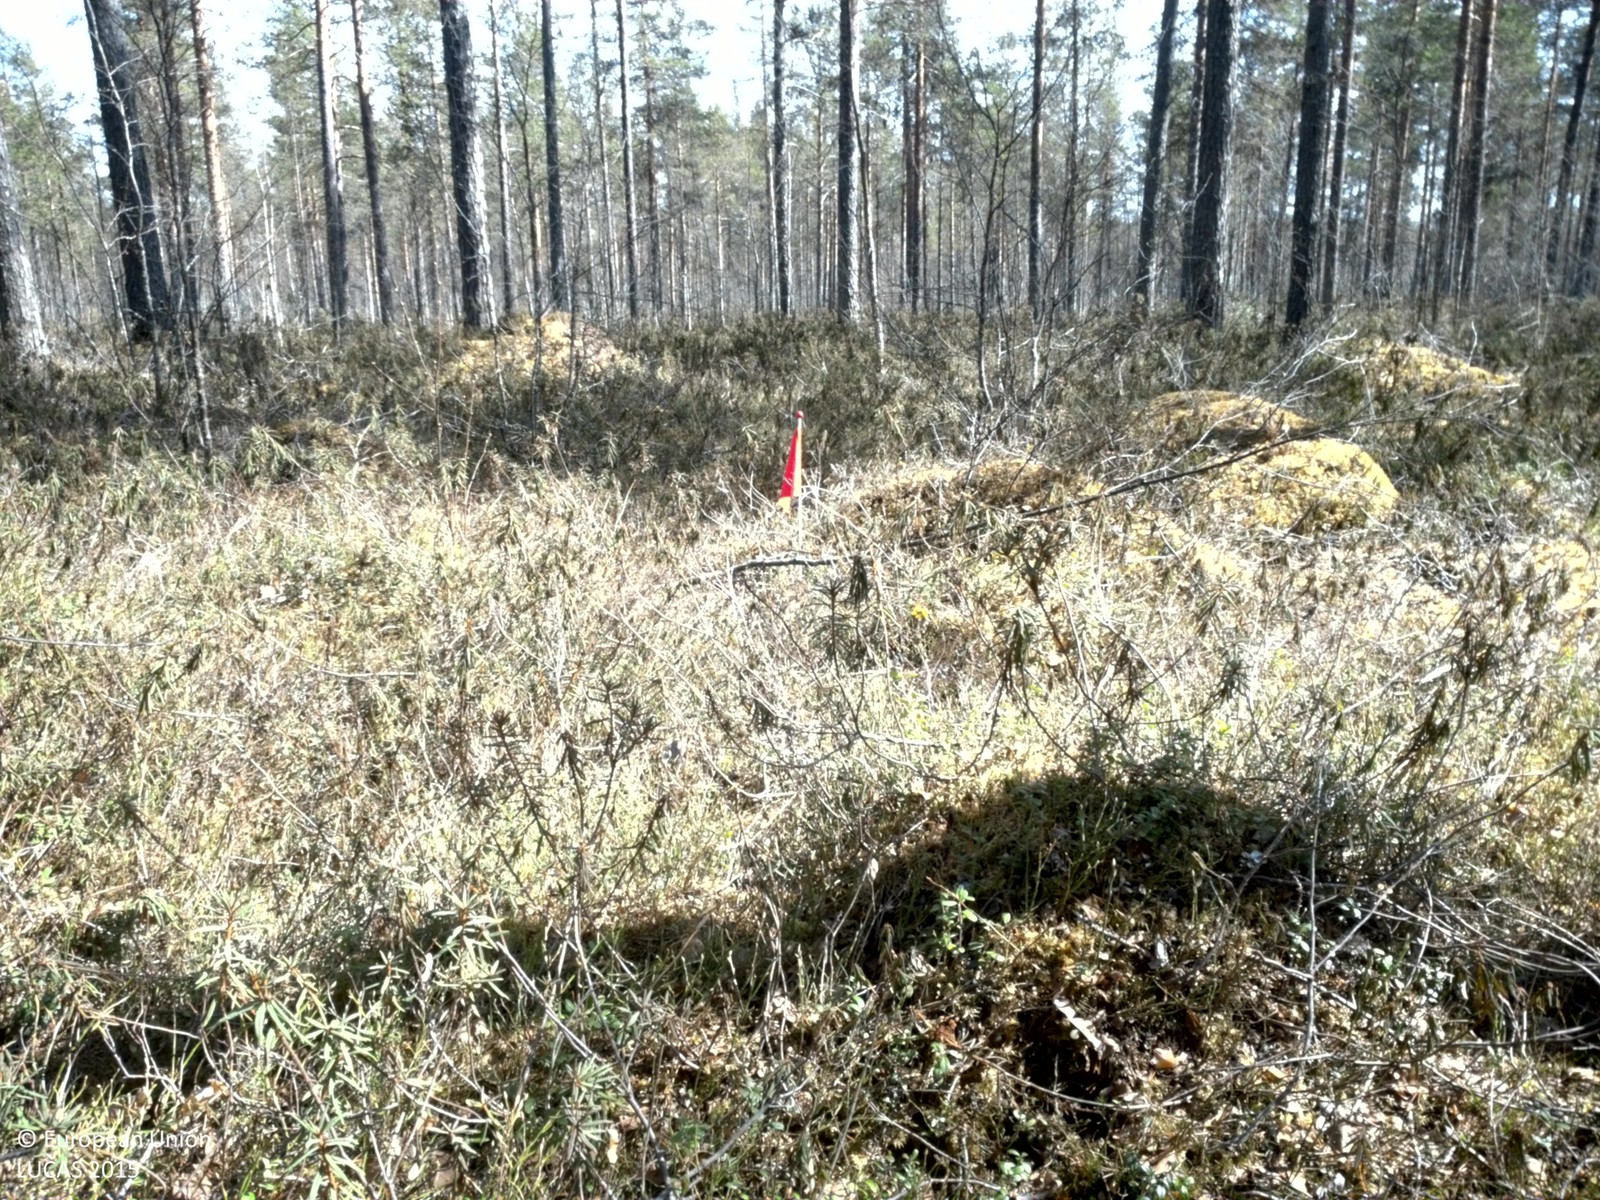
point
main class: Woodland
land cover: Pine dominated mixed woodland
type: boreal forest
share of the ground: 50 - 75 %
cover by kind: coniferous forest trees 45 %, shrubs 40 %, broadleaved forest trees 15 %
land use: Forestry
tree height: > 5 m
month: May
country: SE
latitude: 66.3005
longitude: 23.5207
